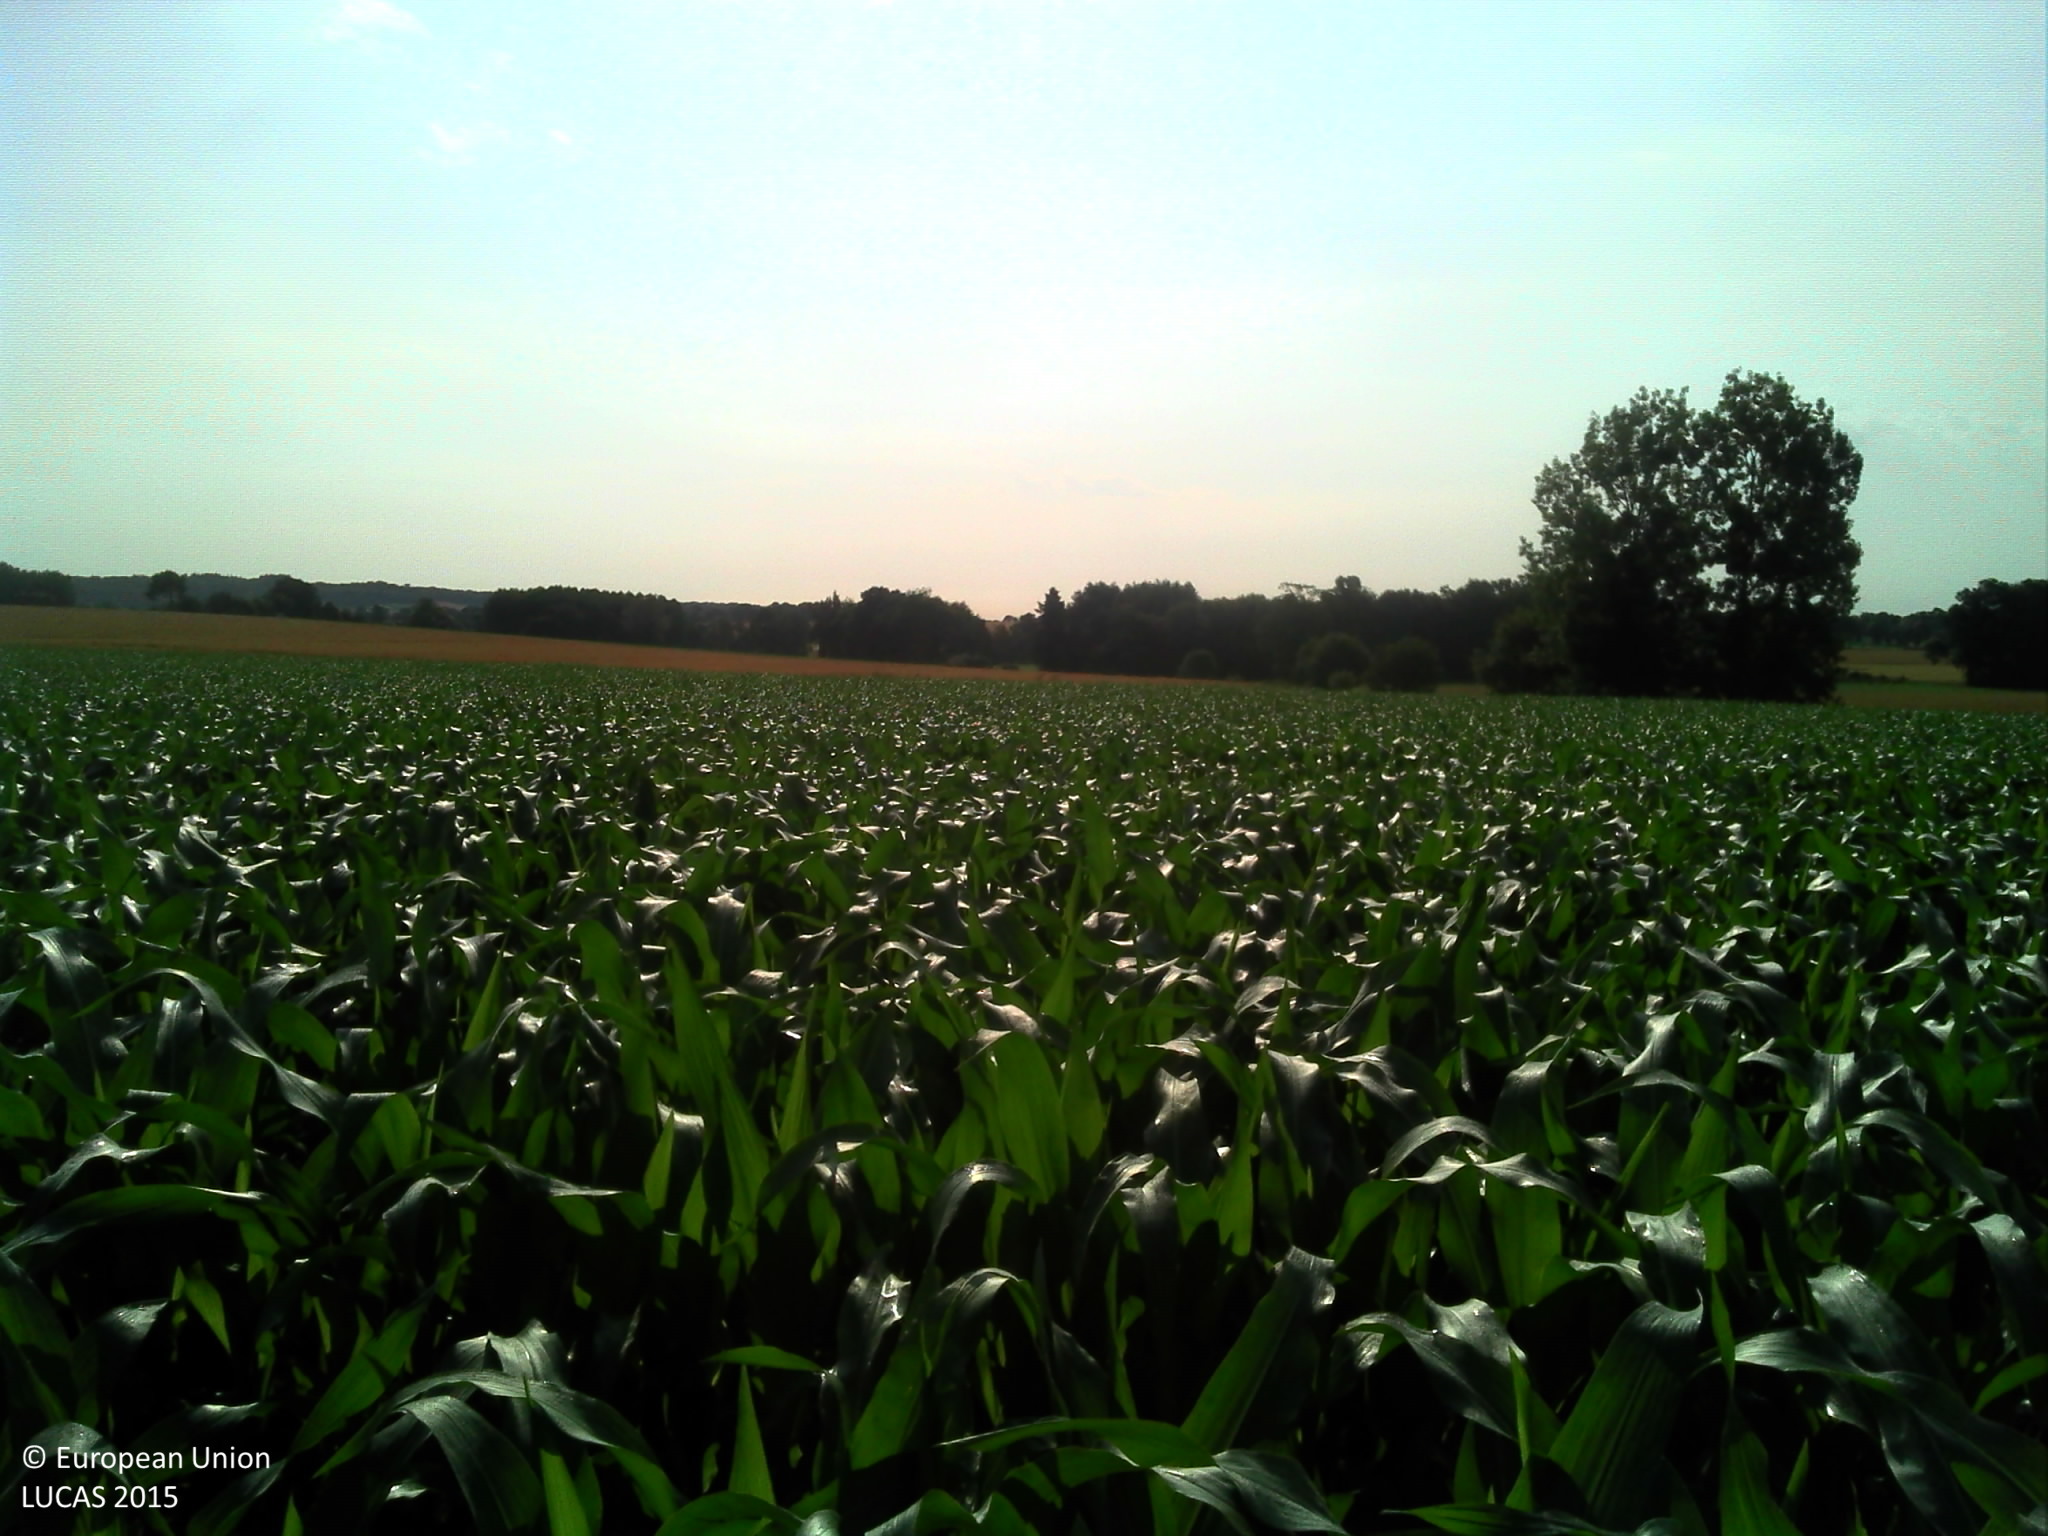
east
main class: Cropland
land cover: Maize
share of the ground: > 75 %
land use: Agriculture (excluding fallow land and kitchen gardens)
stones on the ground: < 10 %
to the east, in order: Maize; Grass margins; Common wheat
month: July
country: FR
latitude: 48.4144
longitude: -1.5452
